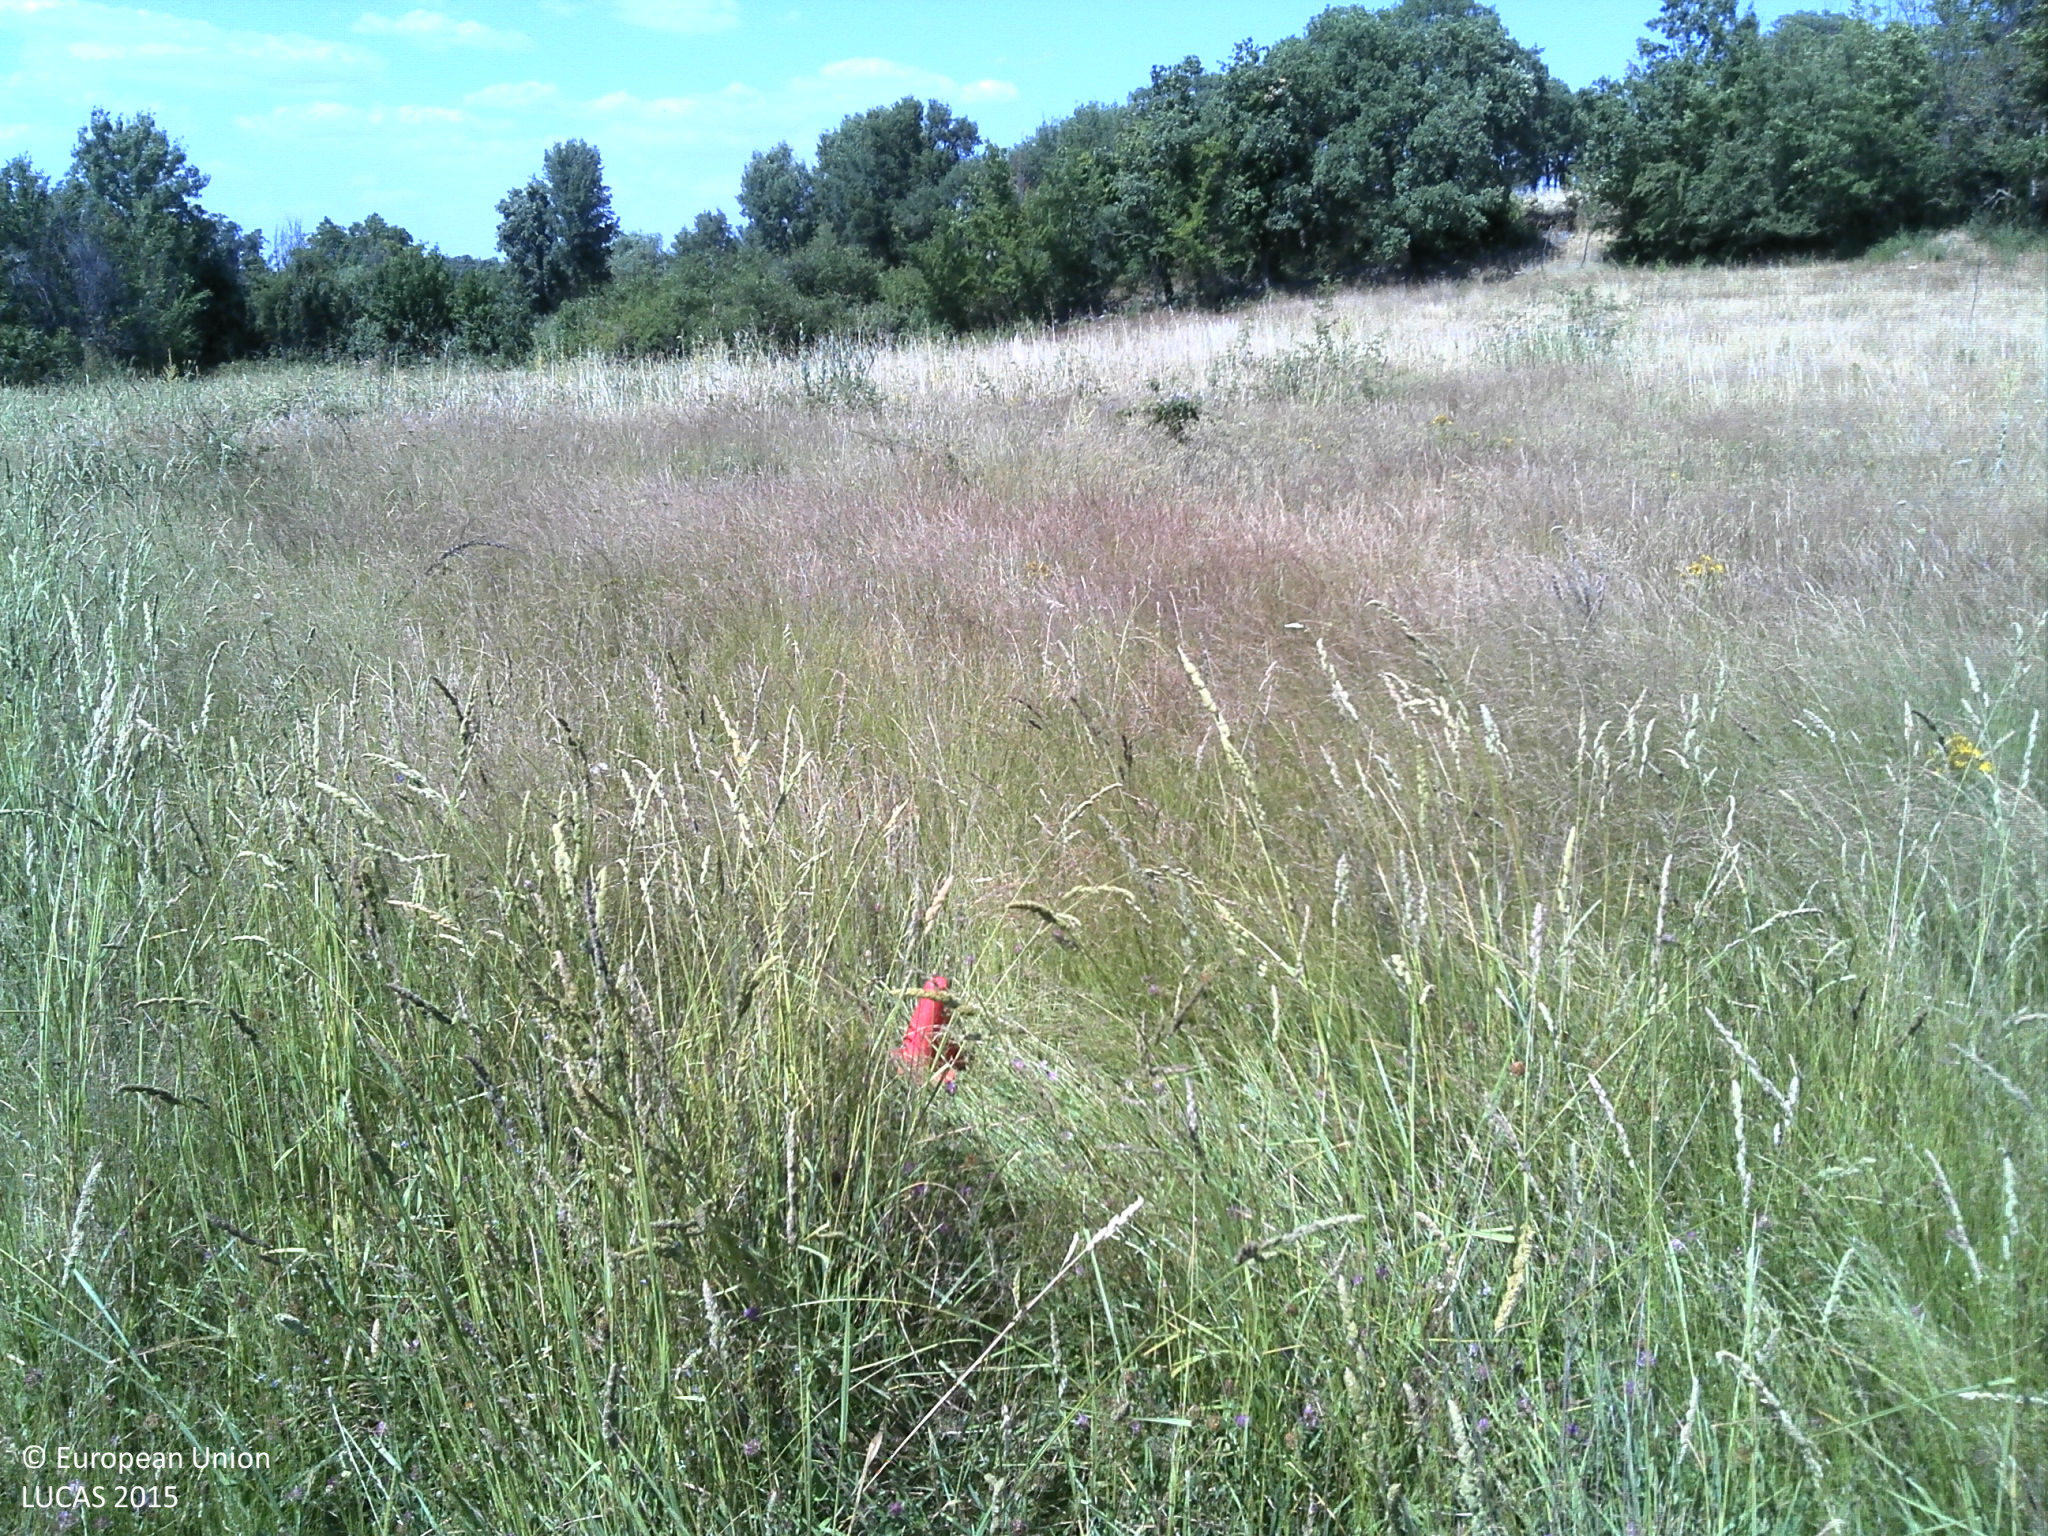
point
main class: Grassland
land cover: Grassland without tree/shrub cover
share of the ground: > 75 %
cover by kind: herbaceous plants 100 %
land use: Agriculture (excluding fallow land and kitchen gardens)
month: June
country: PT
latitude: 40.8691
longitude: -6.9156
